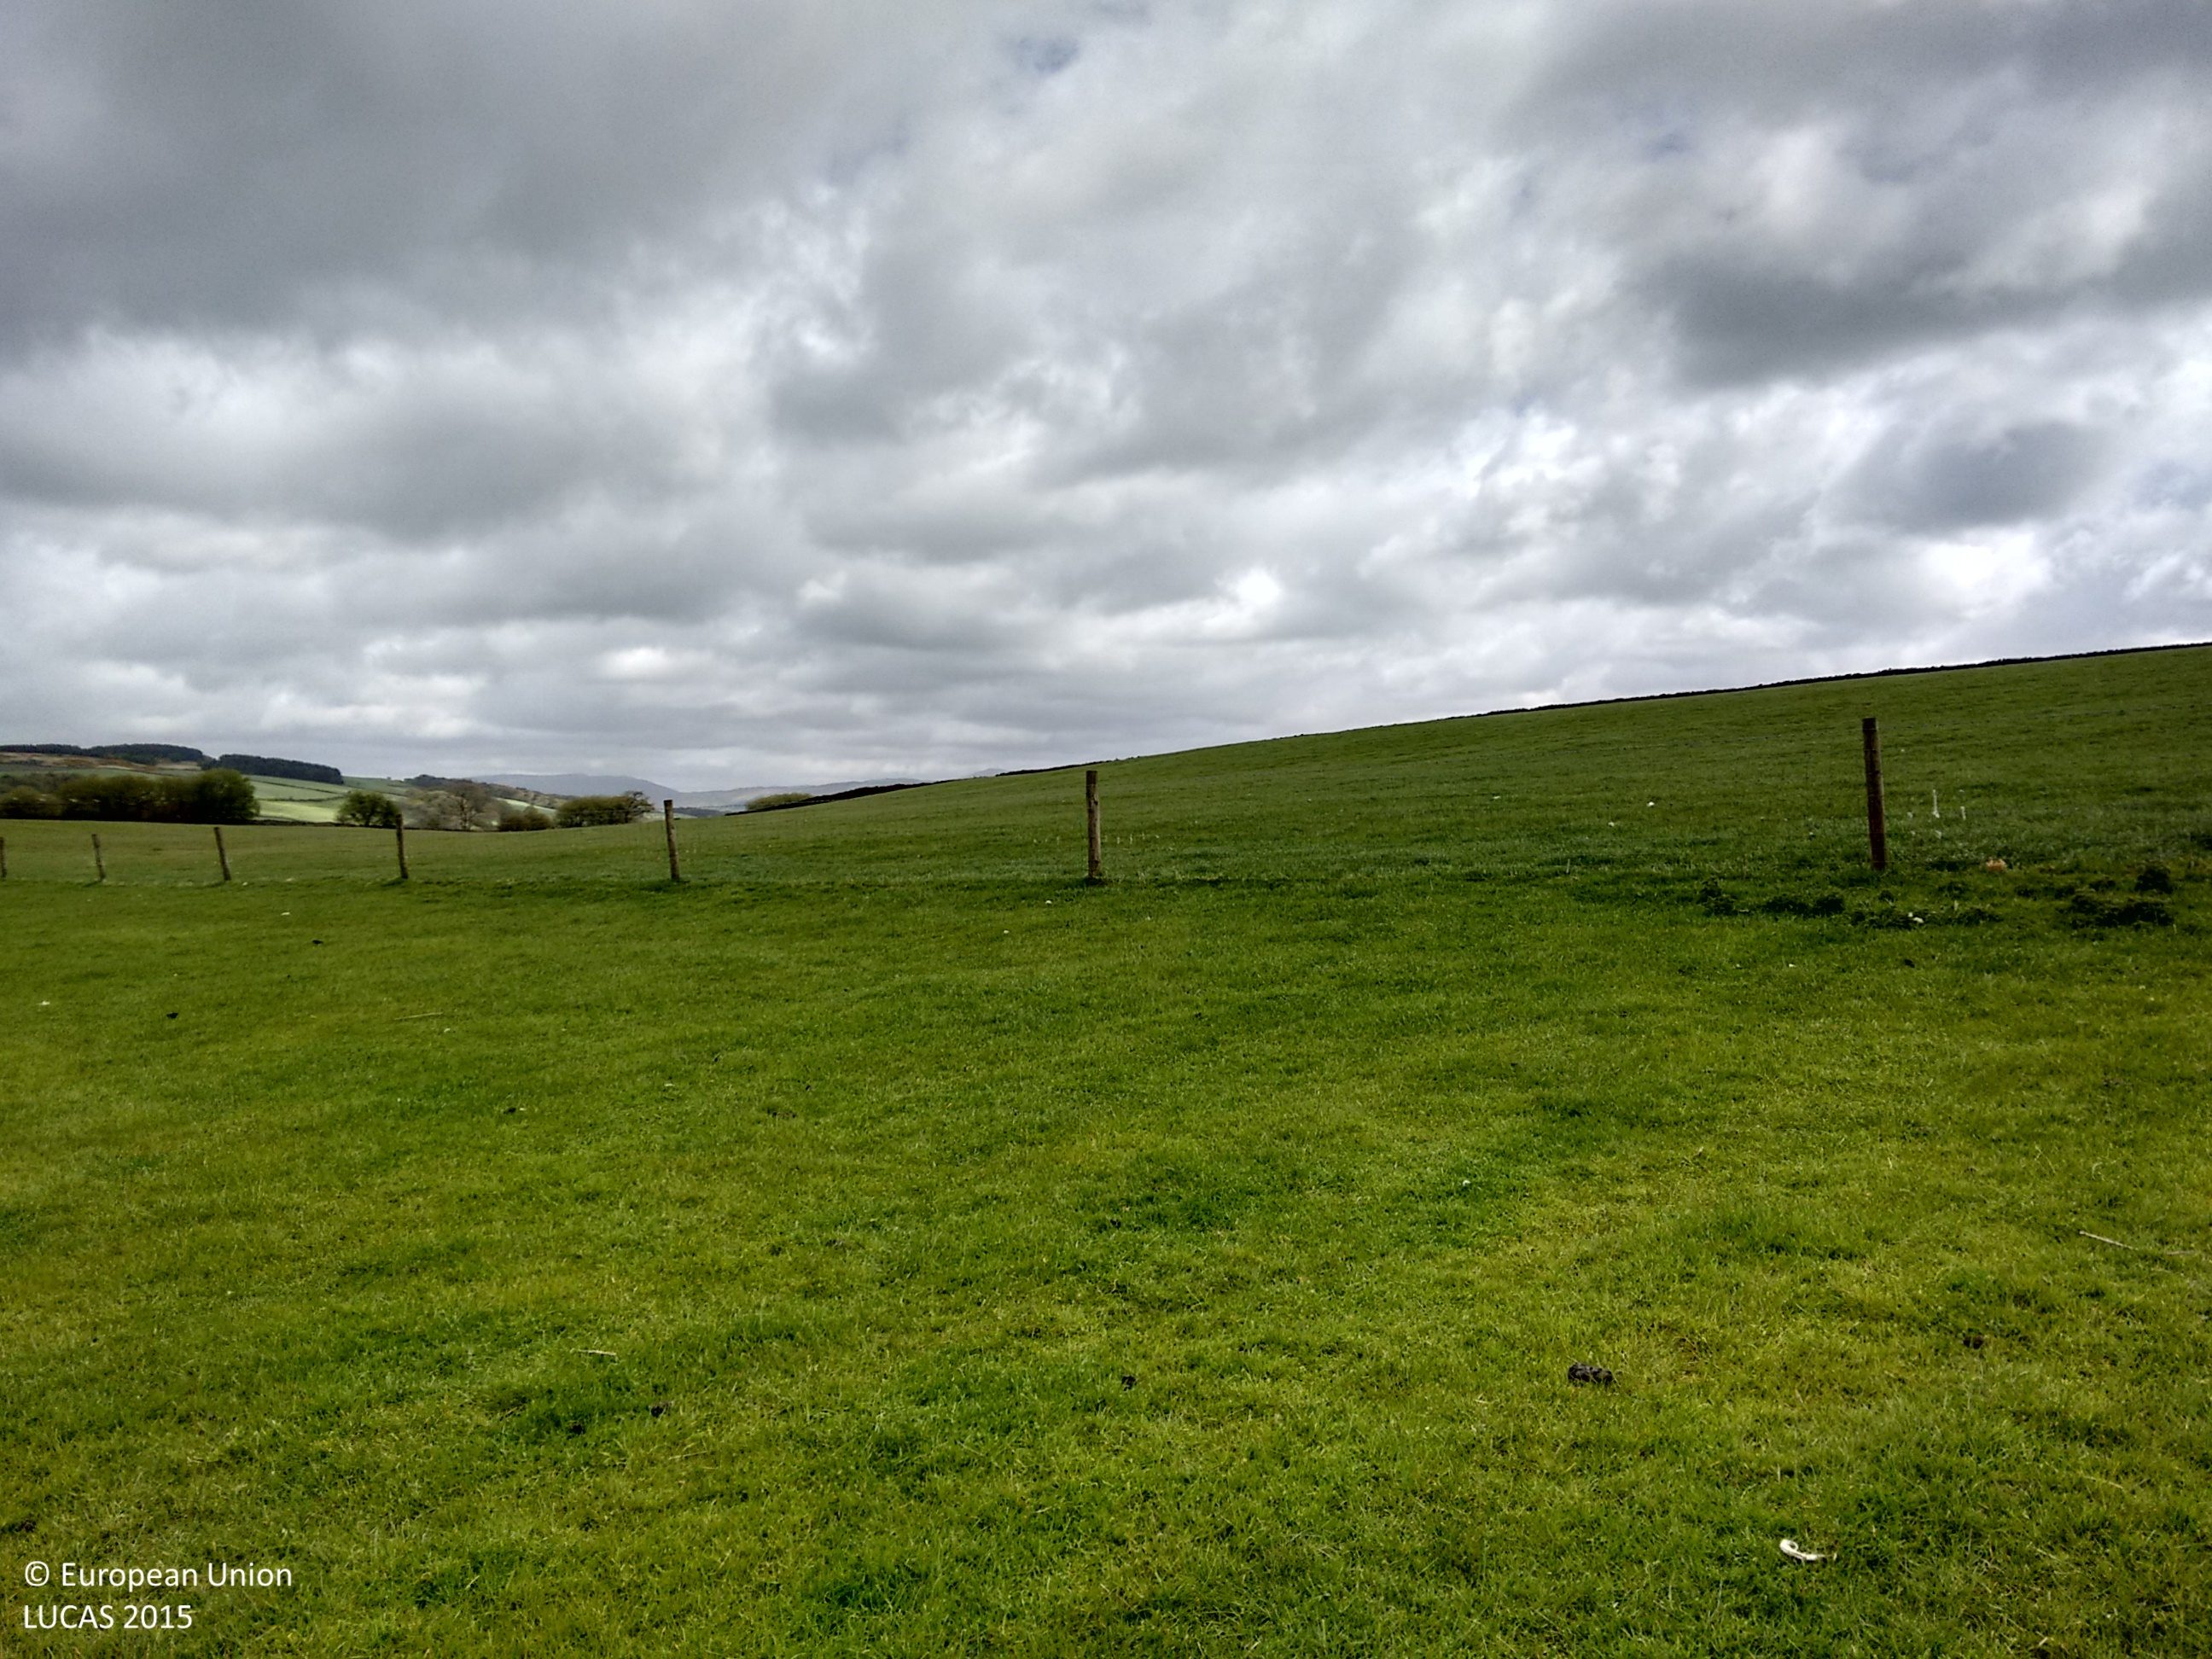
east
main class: Grassland
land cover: Grassland without tree/shrub cover
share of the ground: > 75 %
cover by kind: herbaceous plants 100 %
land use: Agriculture (excluding fallow land and kitchen gardens)
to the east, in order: Grassland without tree/shrub cover
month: May
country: GB
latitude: 54.1537
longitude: -2.6692
